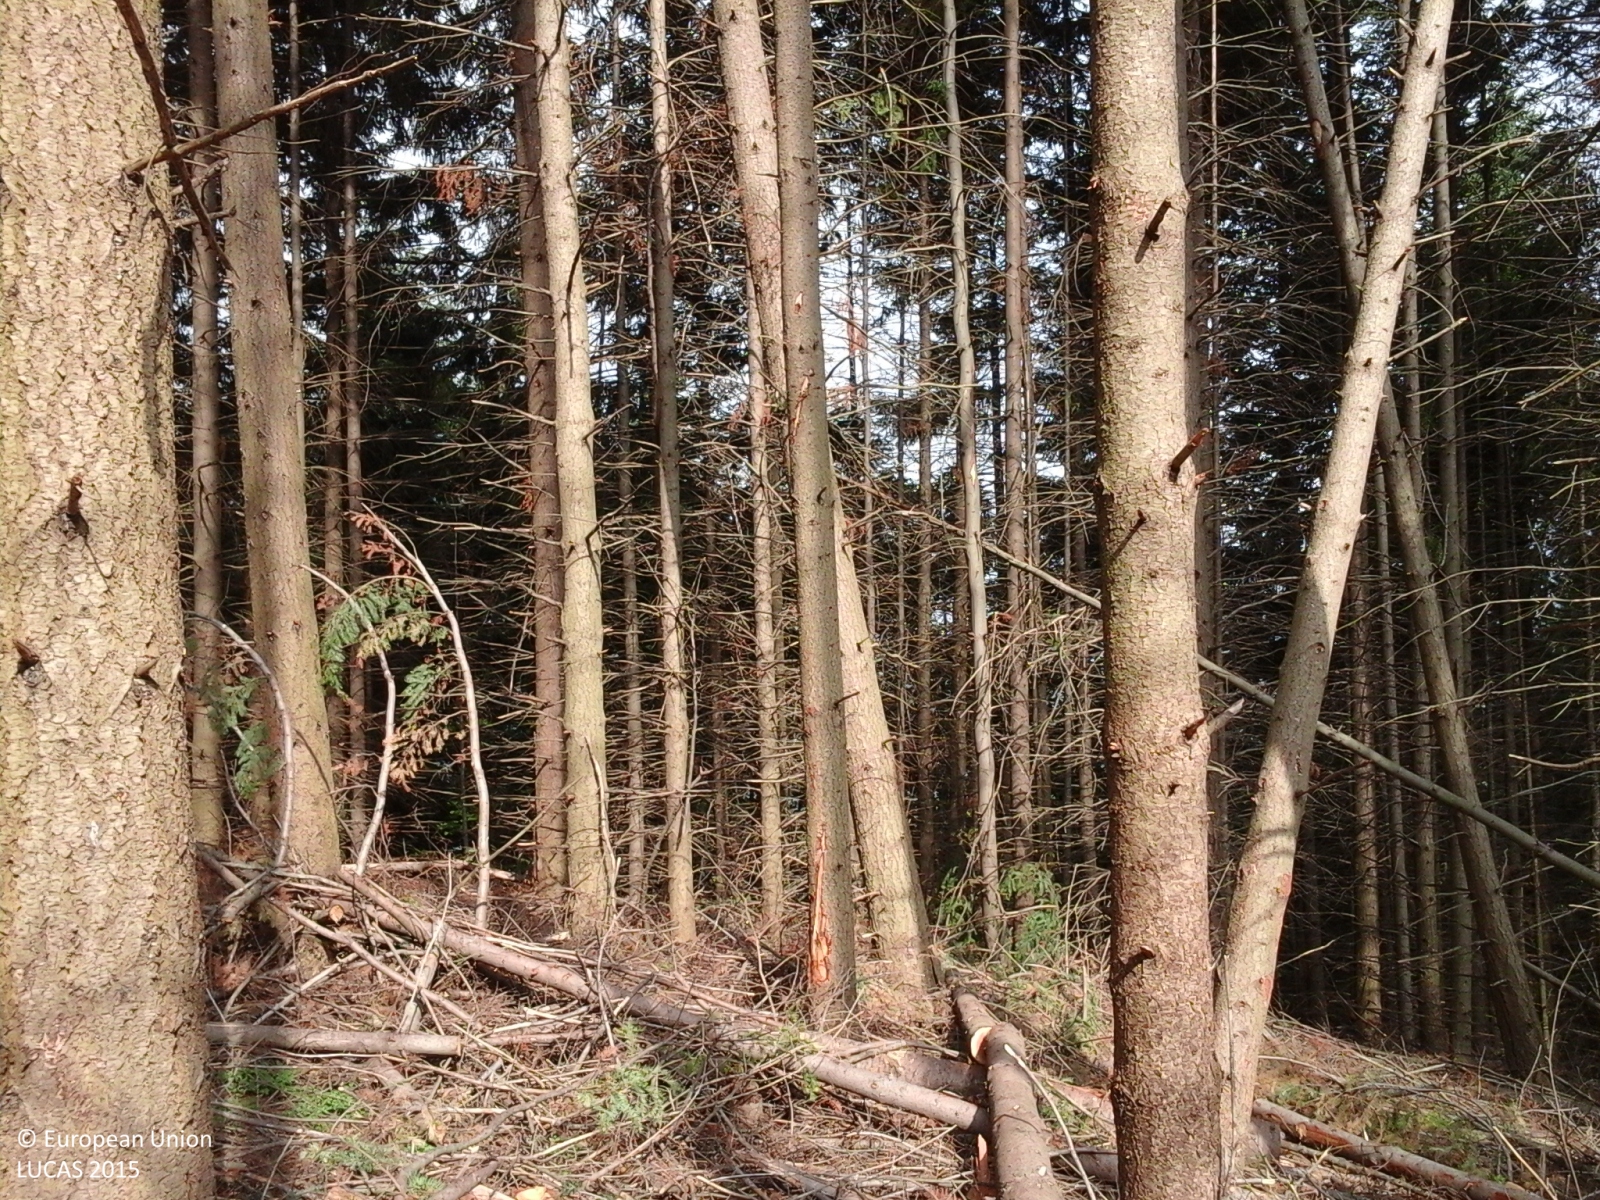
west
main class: Woodland
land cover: Other coniferous woodland
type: coniferous forest of the mediterranean region
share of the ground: > 75 %
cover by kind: coniferous forest trees 80 %, broadleaved forest trees 20 %
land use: Forestry
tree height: > 5 m
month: June
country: IT
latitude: 43.8507
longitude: 11.6255
